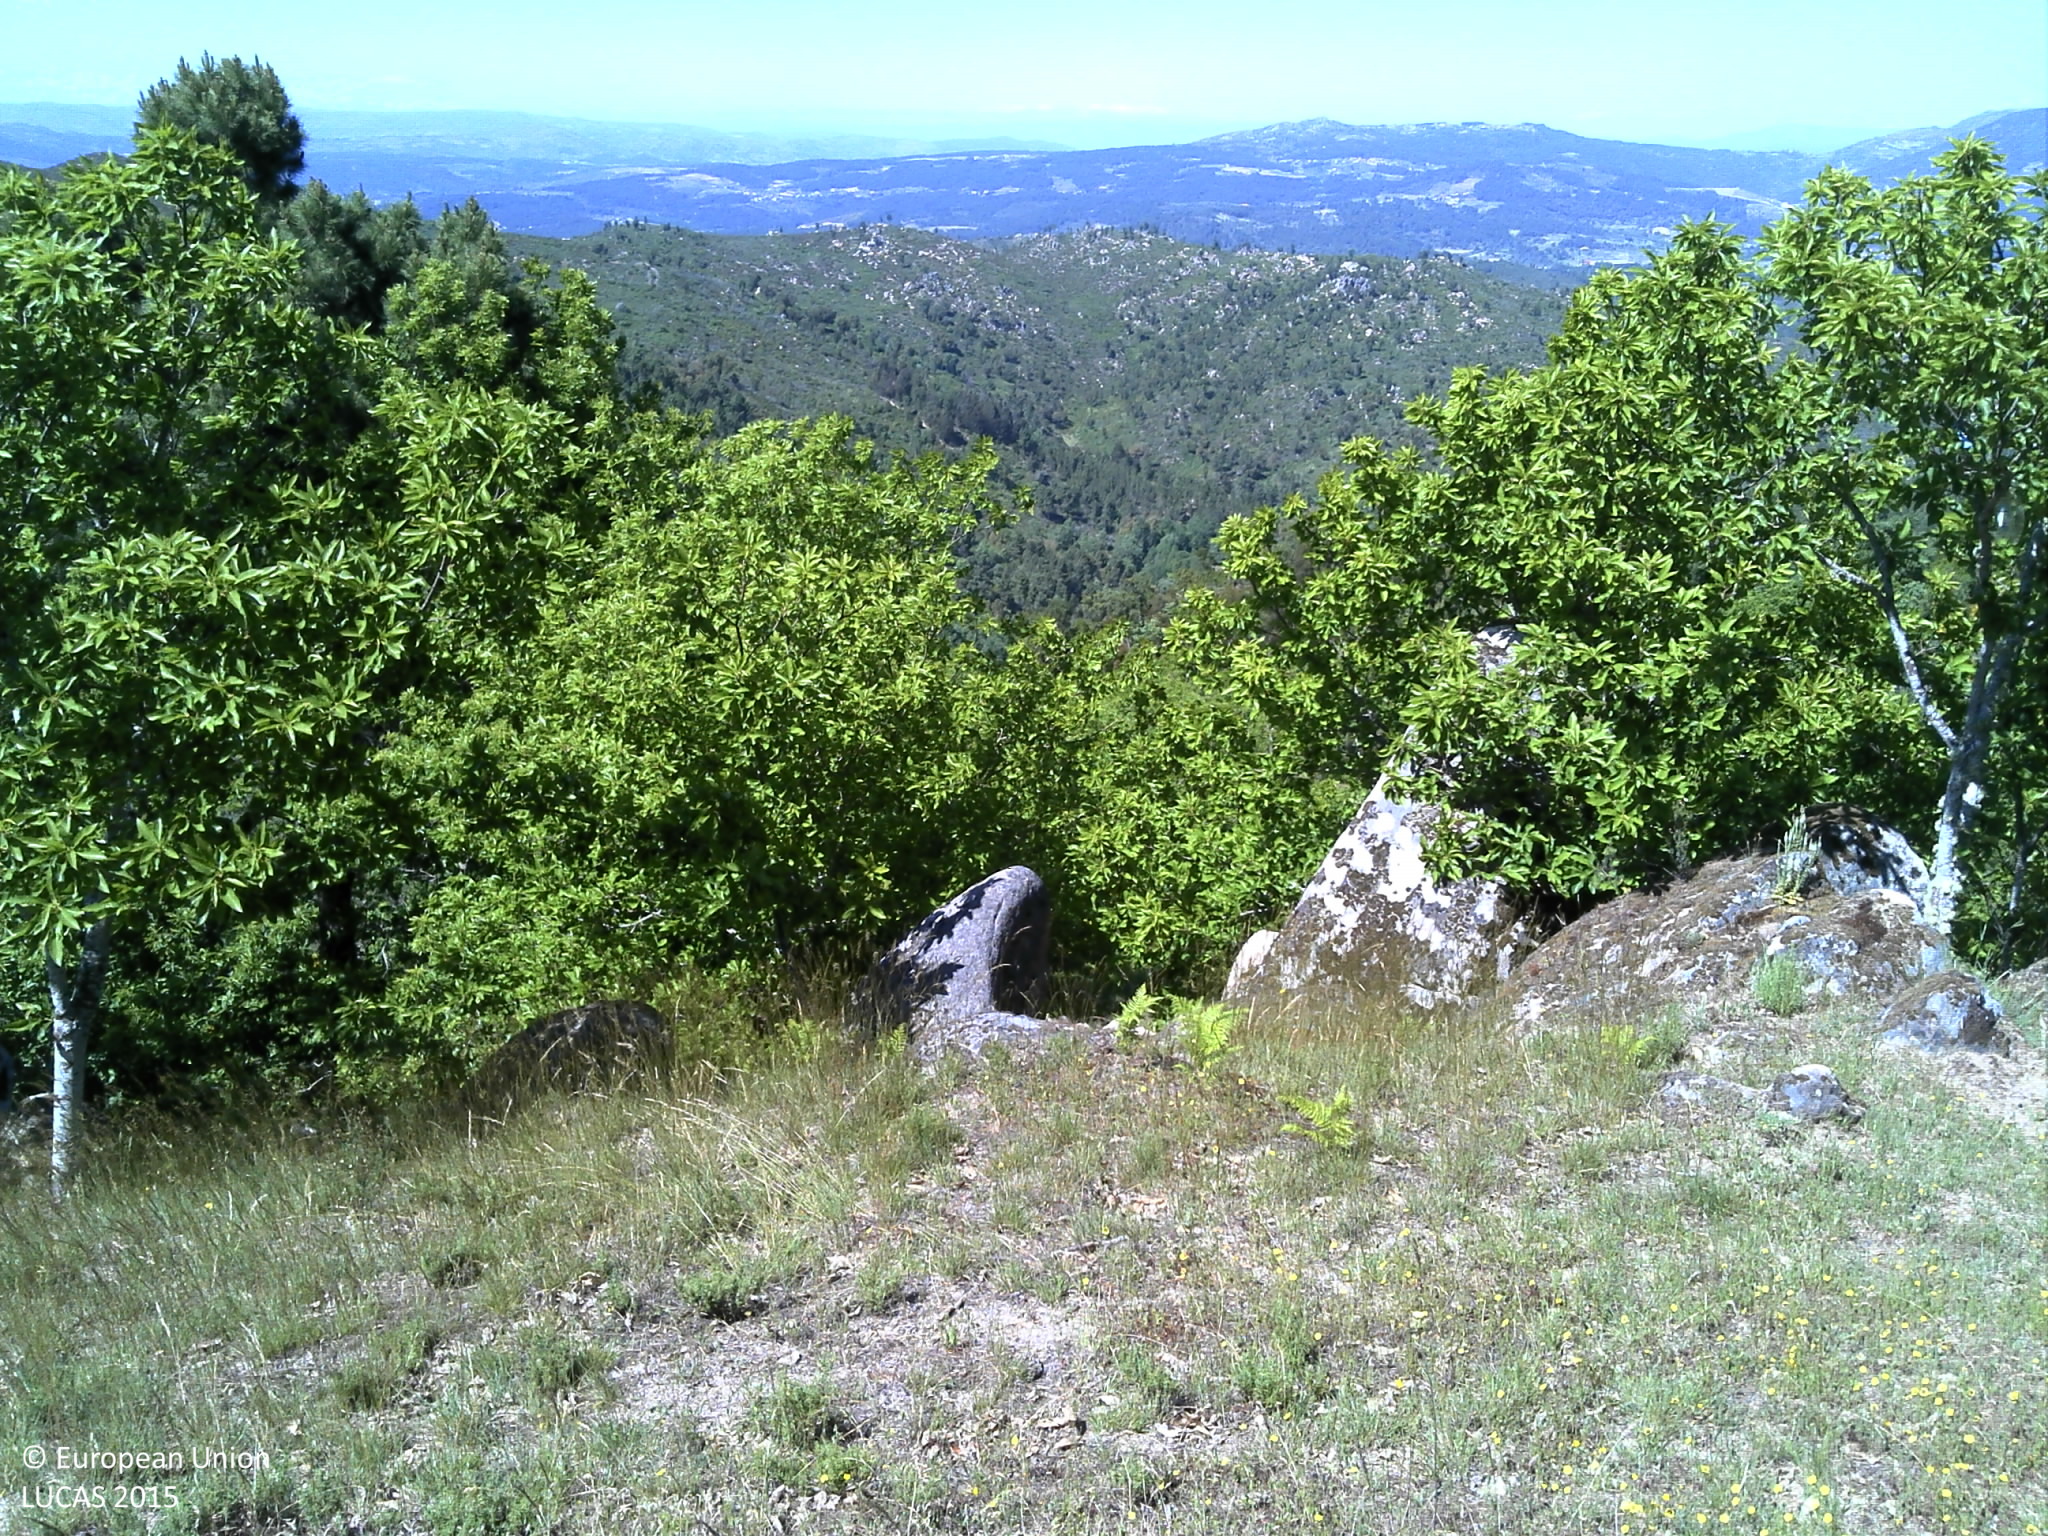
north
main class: Cropland
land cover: Nuts trees
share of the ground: 25 - 50 %
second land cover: Grassland without tree/shrub cover
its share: 50 - 75 %
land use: Agriculture (excluding fallow land and kitchen gardens)
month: May
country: PT
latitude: 41.5853
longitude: -7.5592
